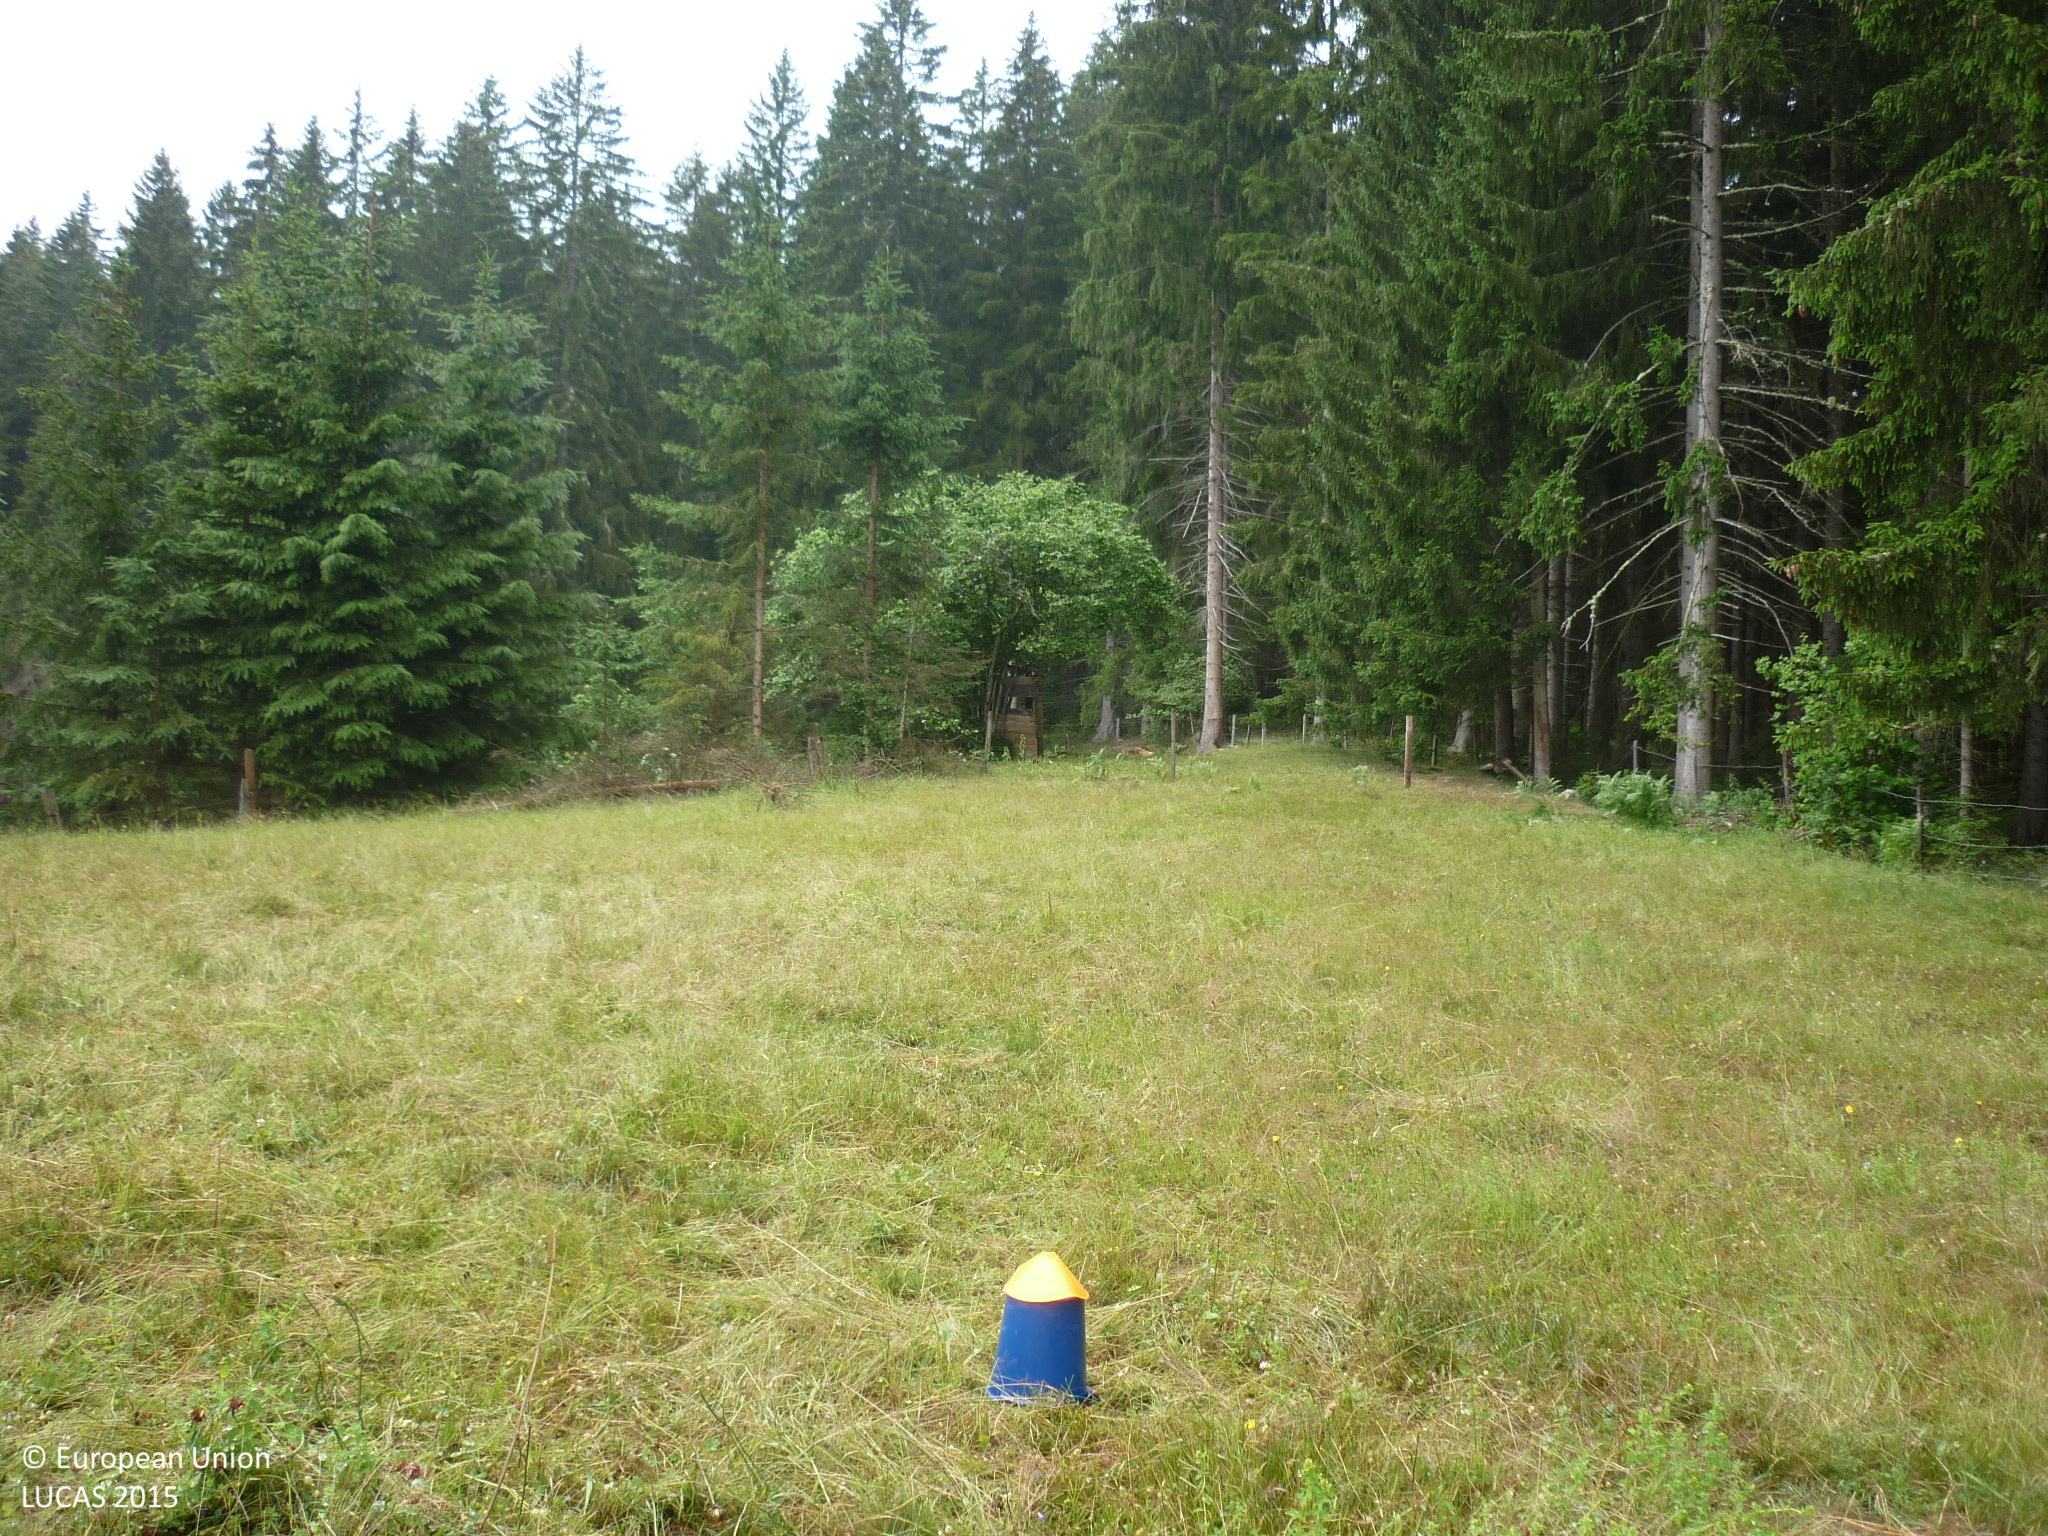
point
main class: Grassland
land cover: Grassland without tree/shrub cover
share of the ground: > 75 %
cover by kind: herbaceous plants 100 %
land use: Agriculture (excluding fallow land and kitchen gardens)
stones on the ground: < 10 %
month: June
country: AT
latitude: 47.0919
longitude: 14.3588
